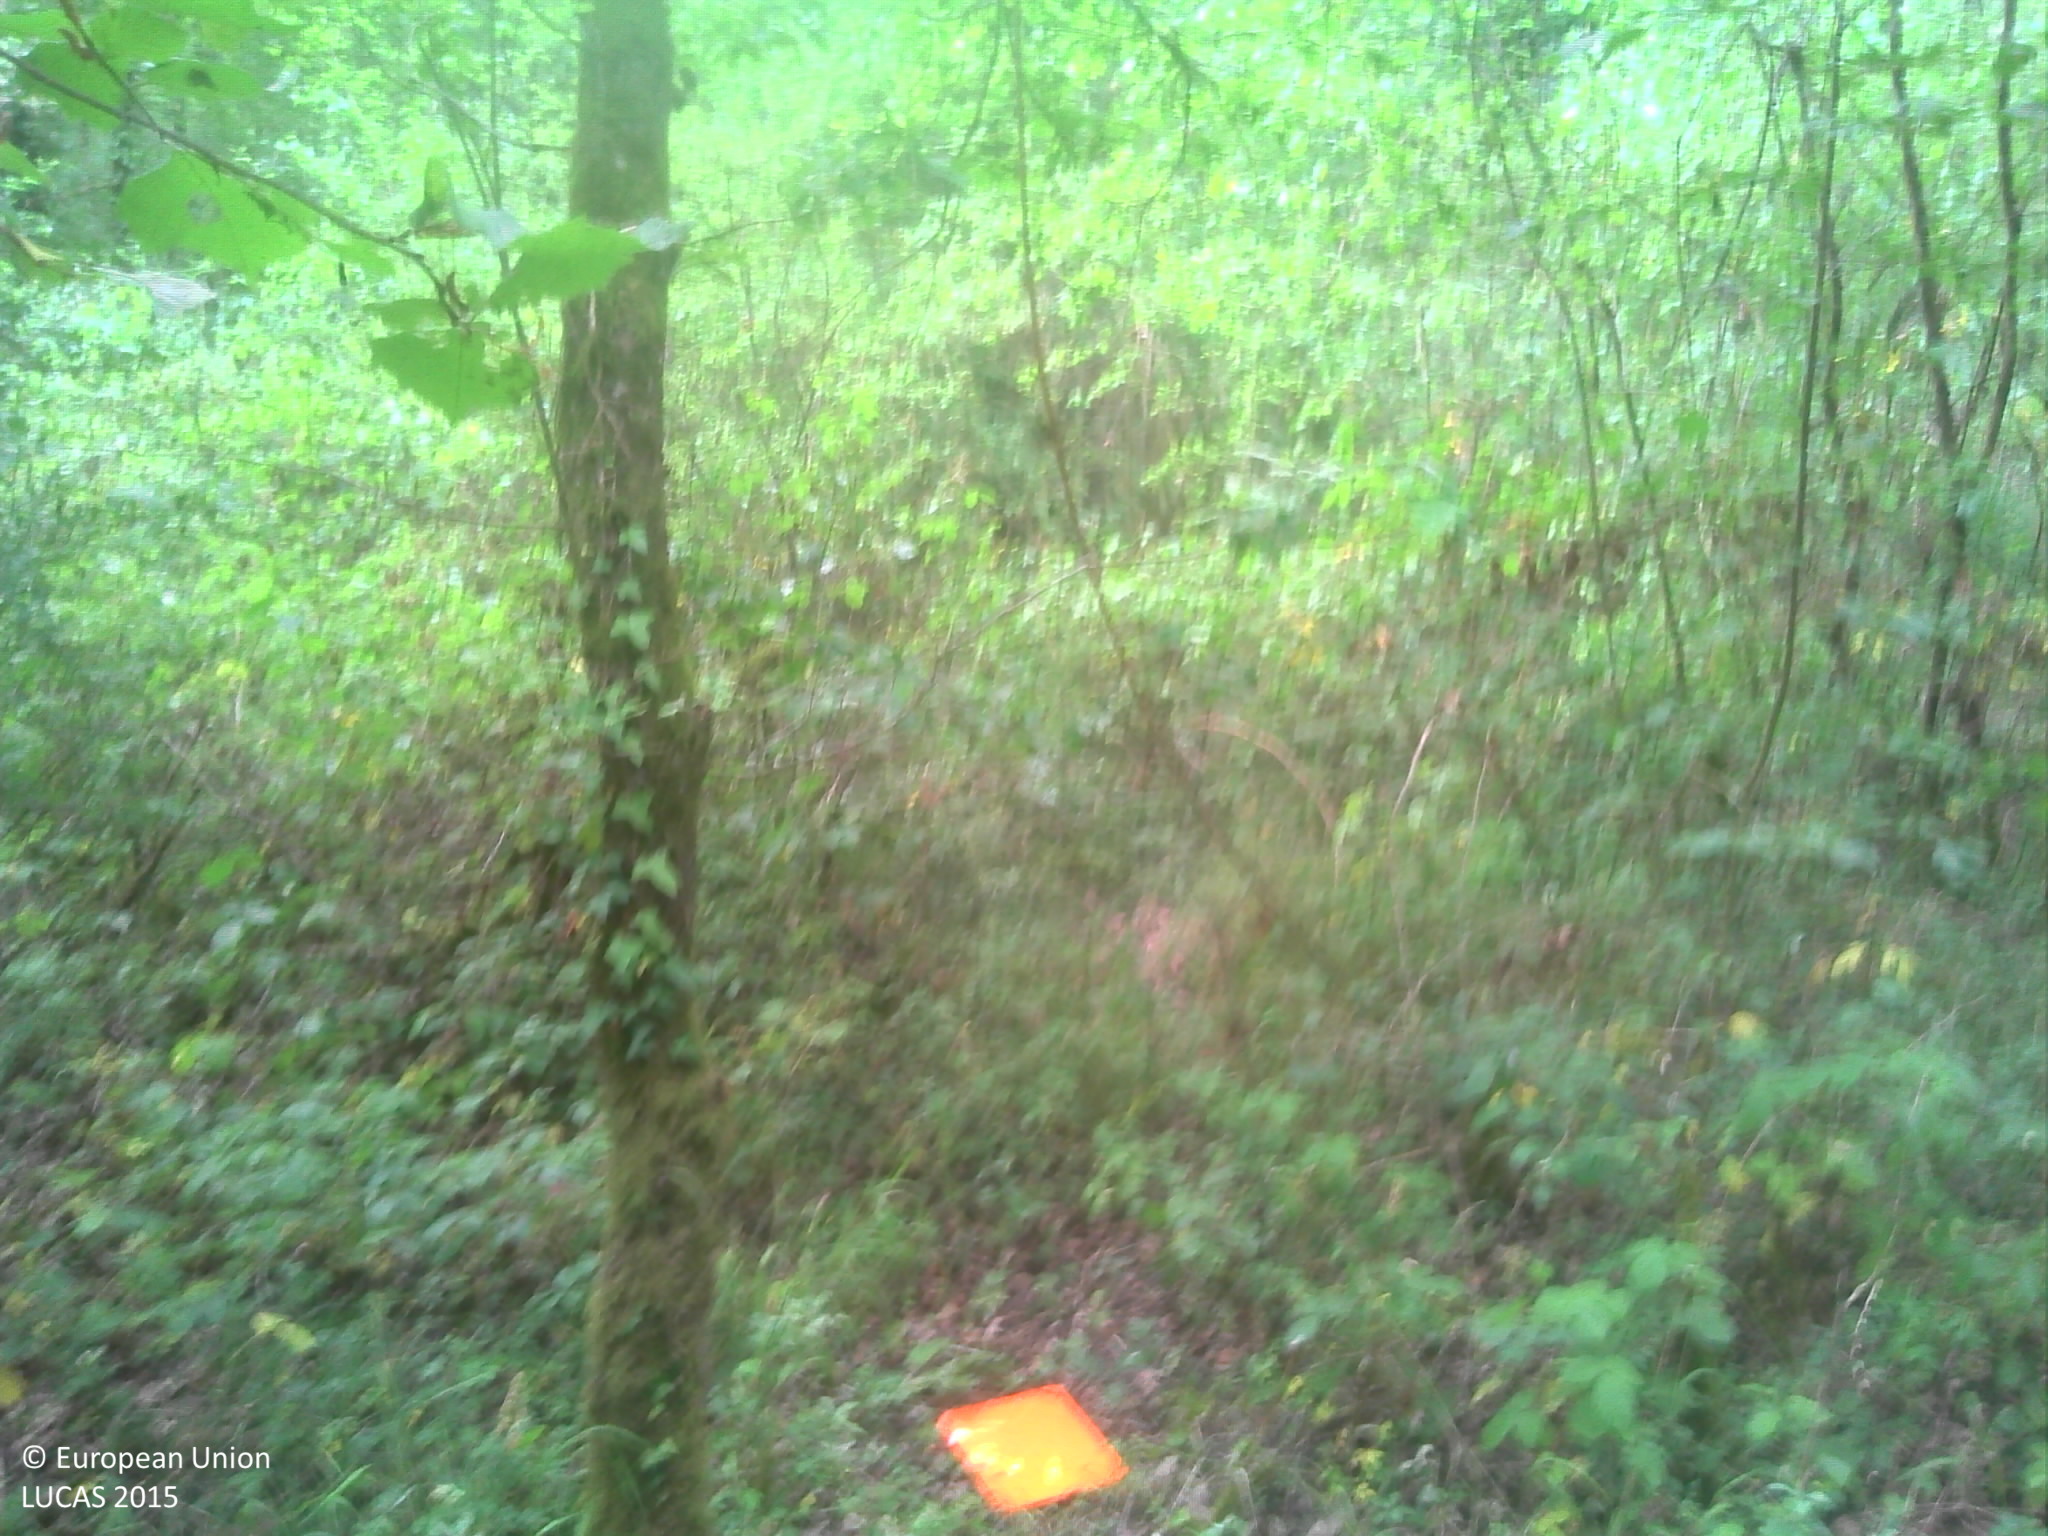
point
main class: Woodland
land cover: Broadleaved woodland
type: mesophytic deciduous forest
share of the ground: > 75 %
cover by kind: broadleaved forest trees 30 %, herbaceous plants 30 %, unconsolidated bare surface 30 %, lichens and mosses 10 %
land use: Forestry
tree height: > 5 m
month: July
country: FR
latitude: 47.5368
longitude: 1.0959
